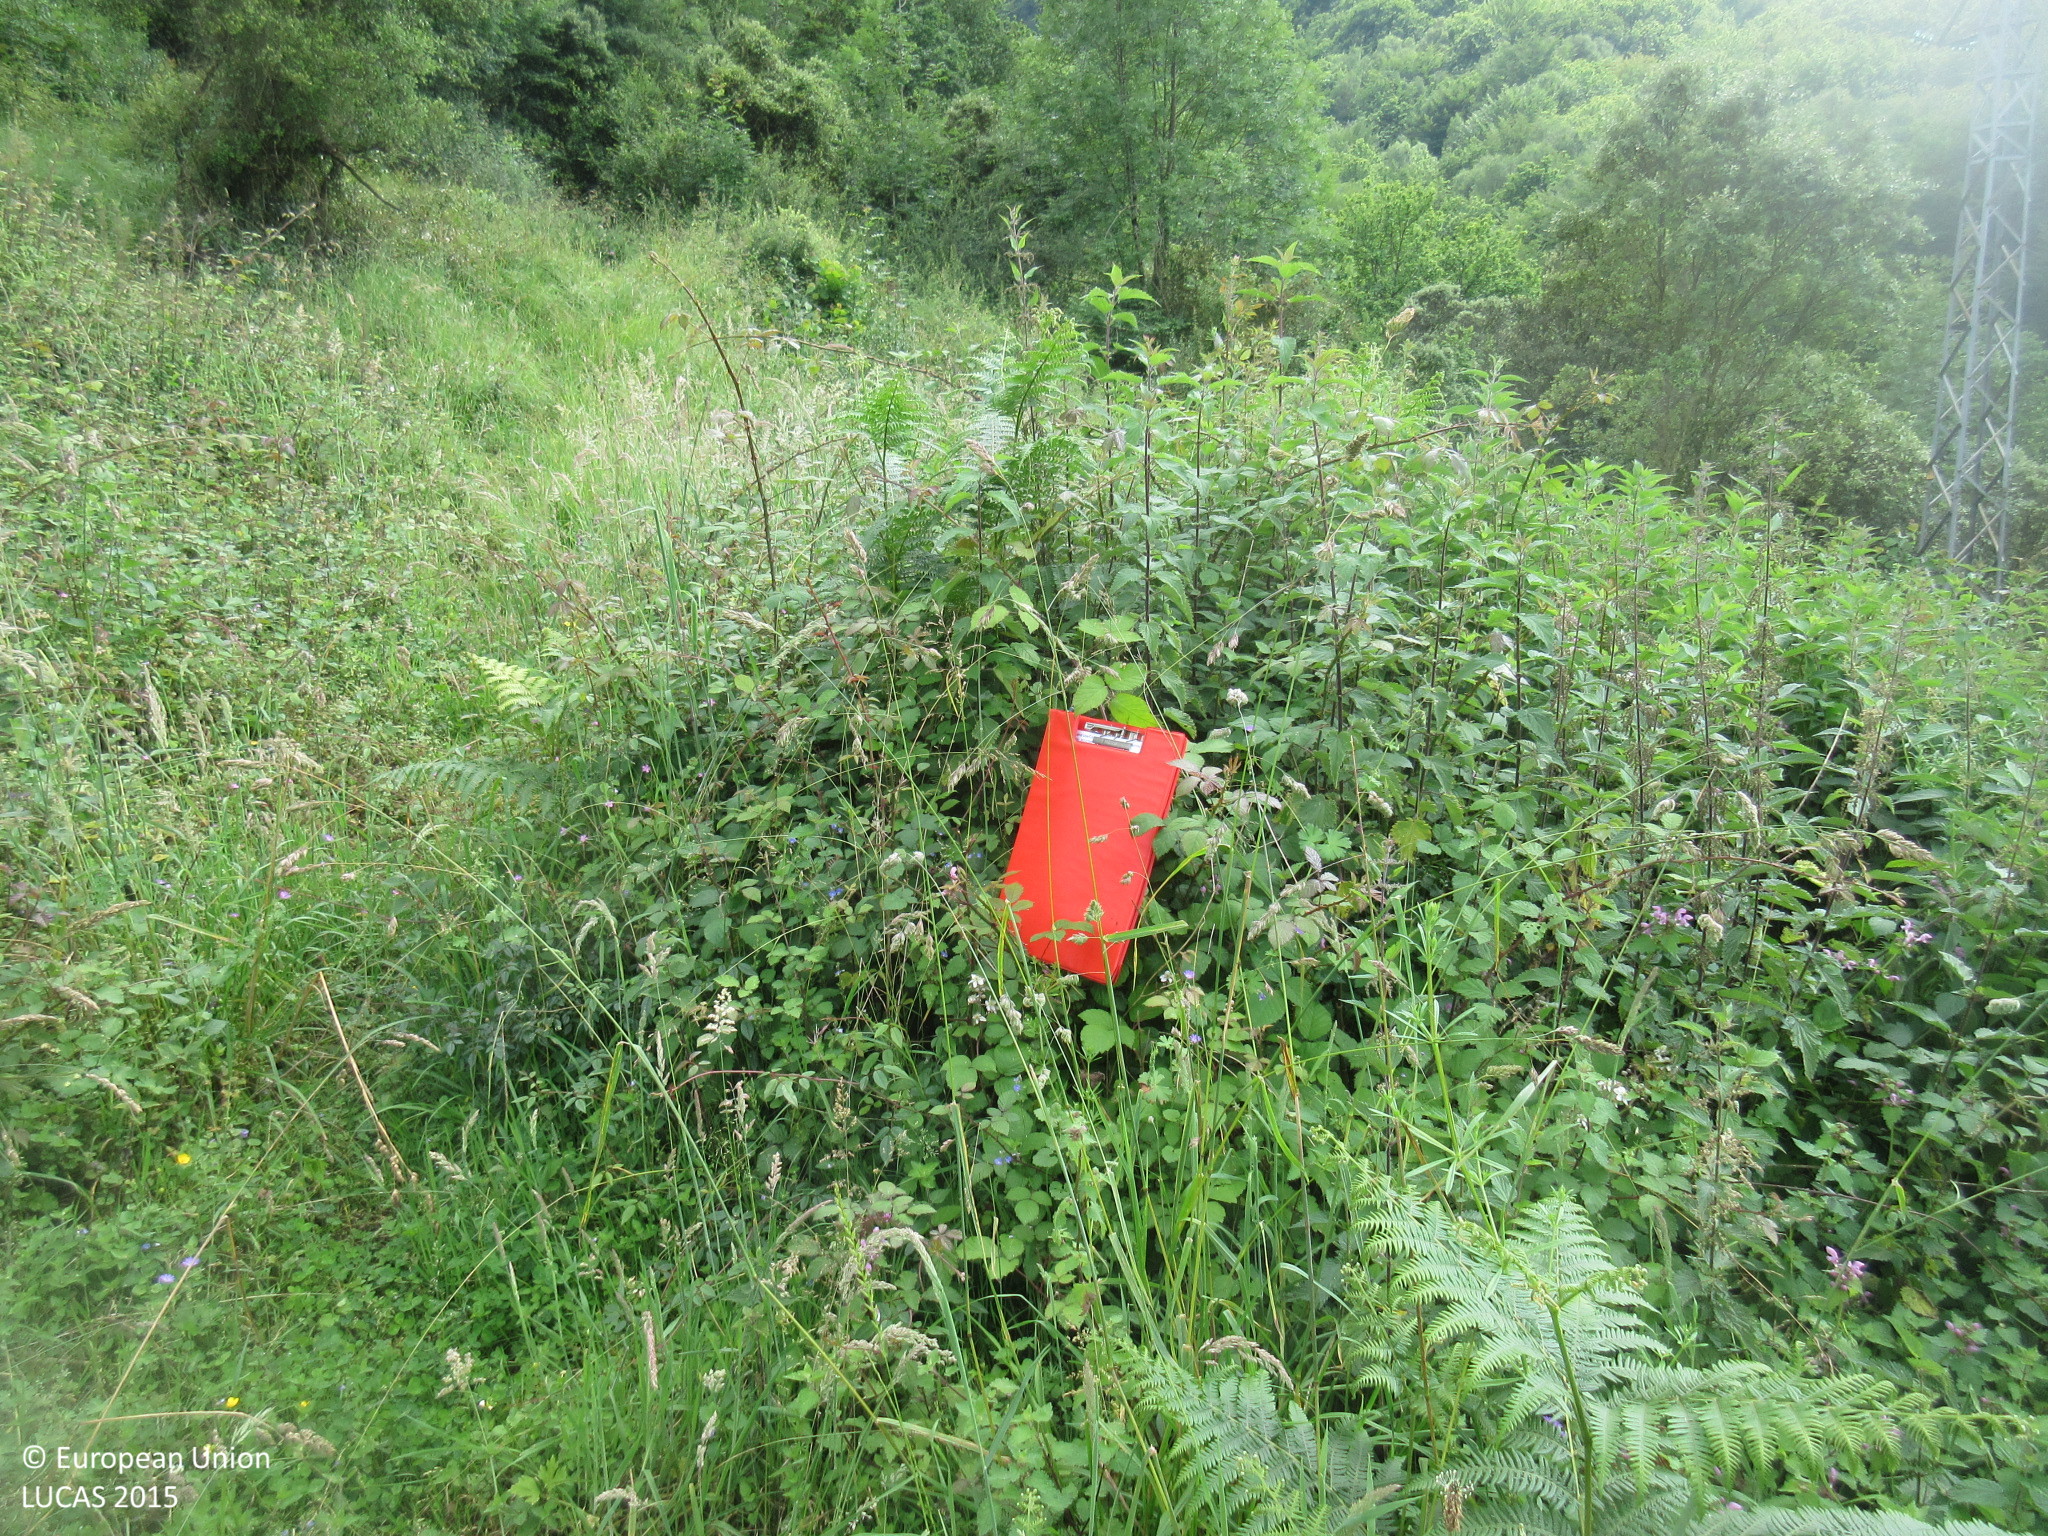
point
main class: Shrubland
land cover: Shrubland without tree cover
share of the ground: > 75 %
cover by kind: shrubs 90 %, herbaceous plants 10 %
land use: Agriculture (excluding fallow land and kitchen gardens)
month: June
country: ES
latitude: 43.2868
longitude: -5.9756
